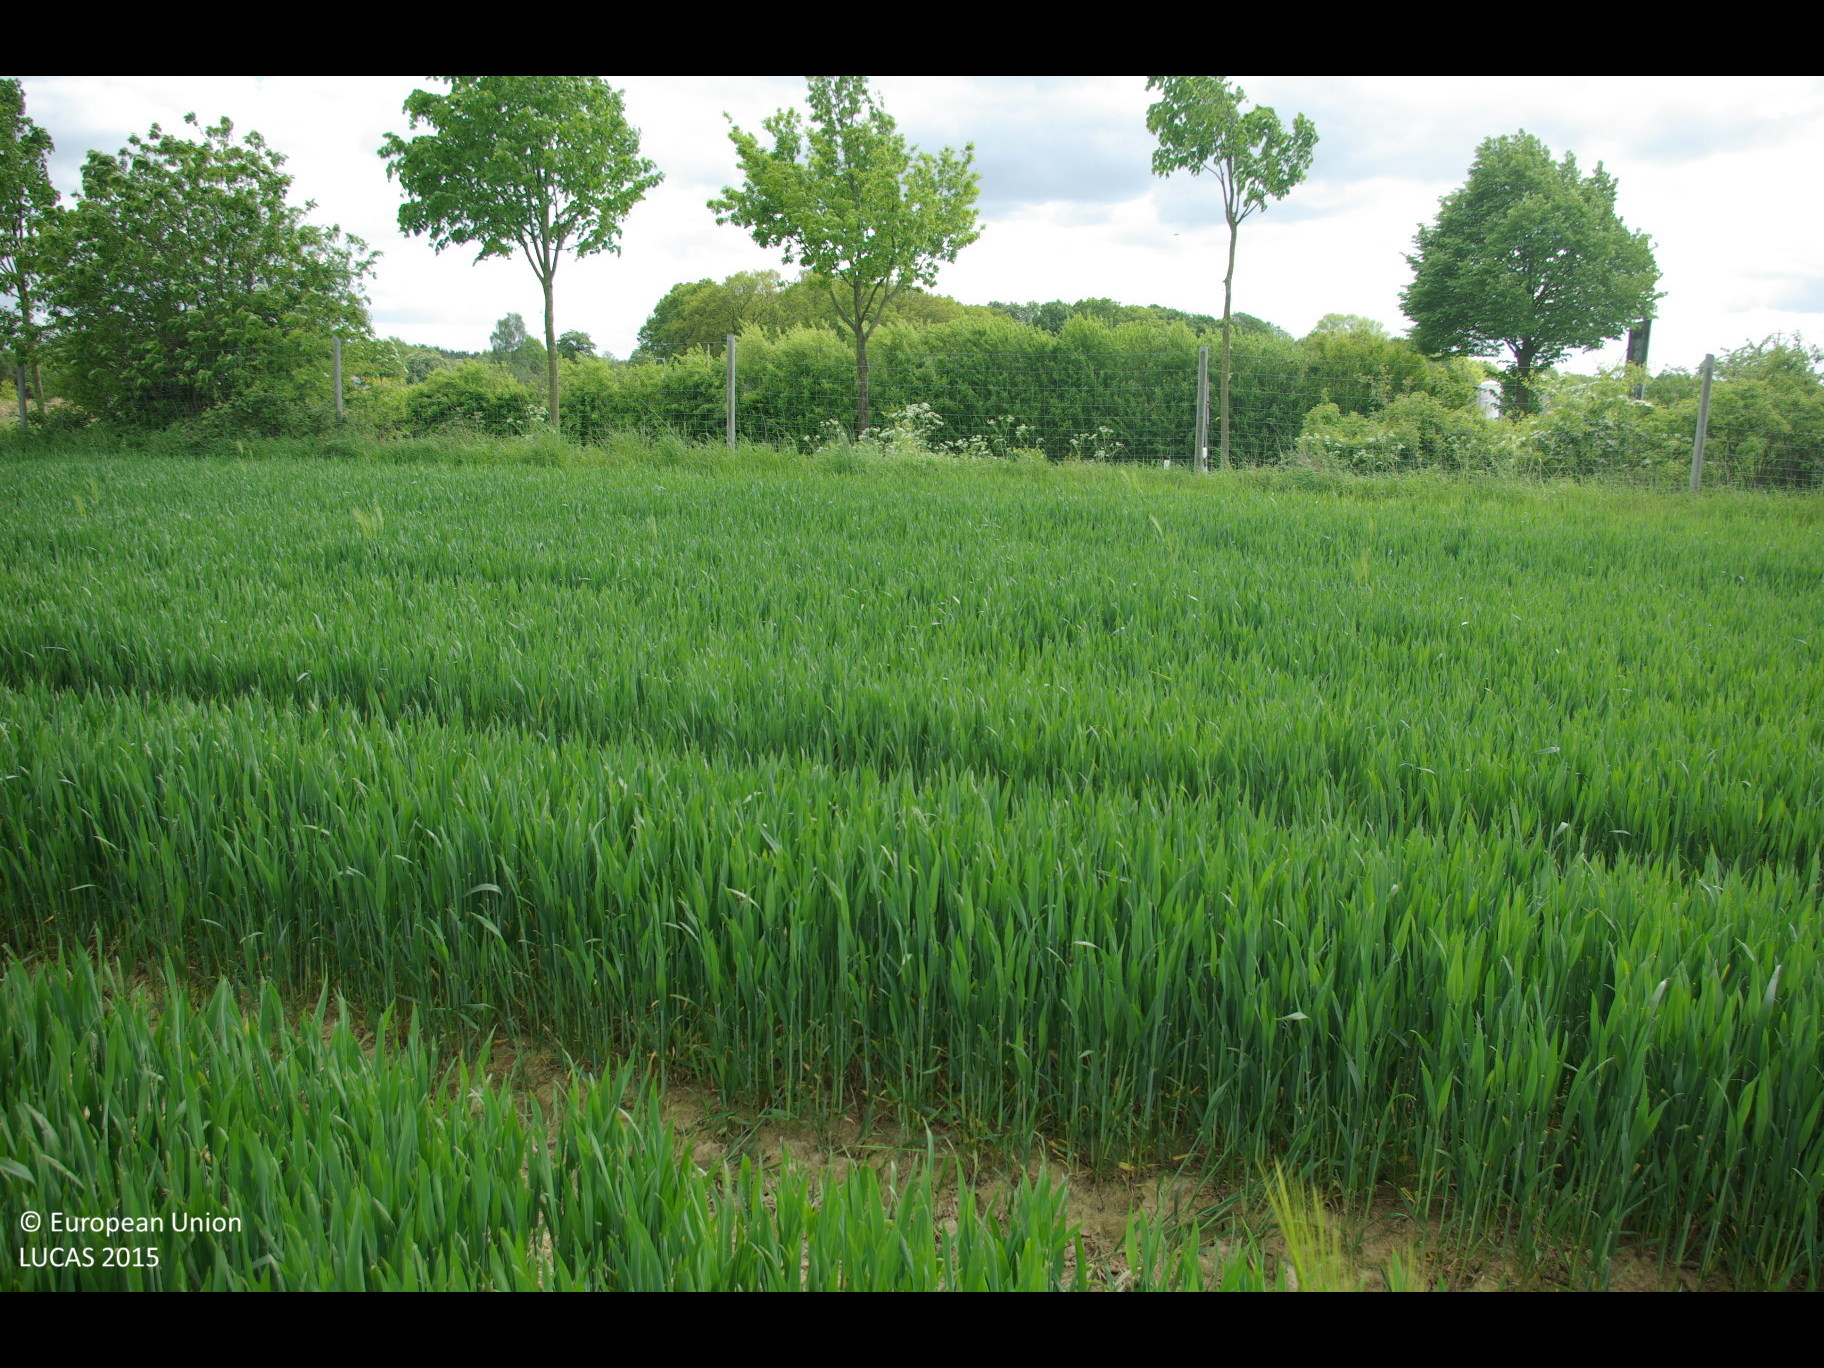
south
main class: Cropland
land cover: Common wheat
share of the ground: > 75 %
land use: Agriculture (excluding fallow land and kitchen gardens)
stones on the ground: < 10 %
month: May
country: DE
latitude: 54.3185
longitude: 9.9539
